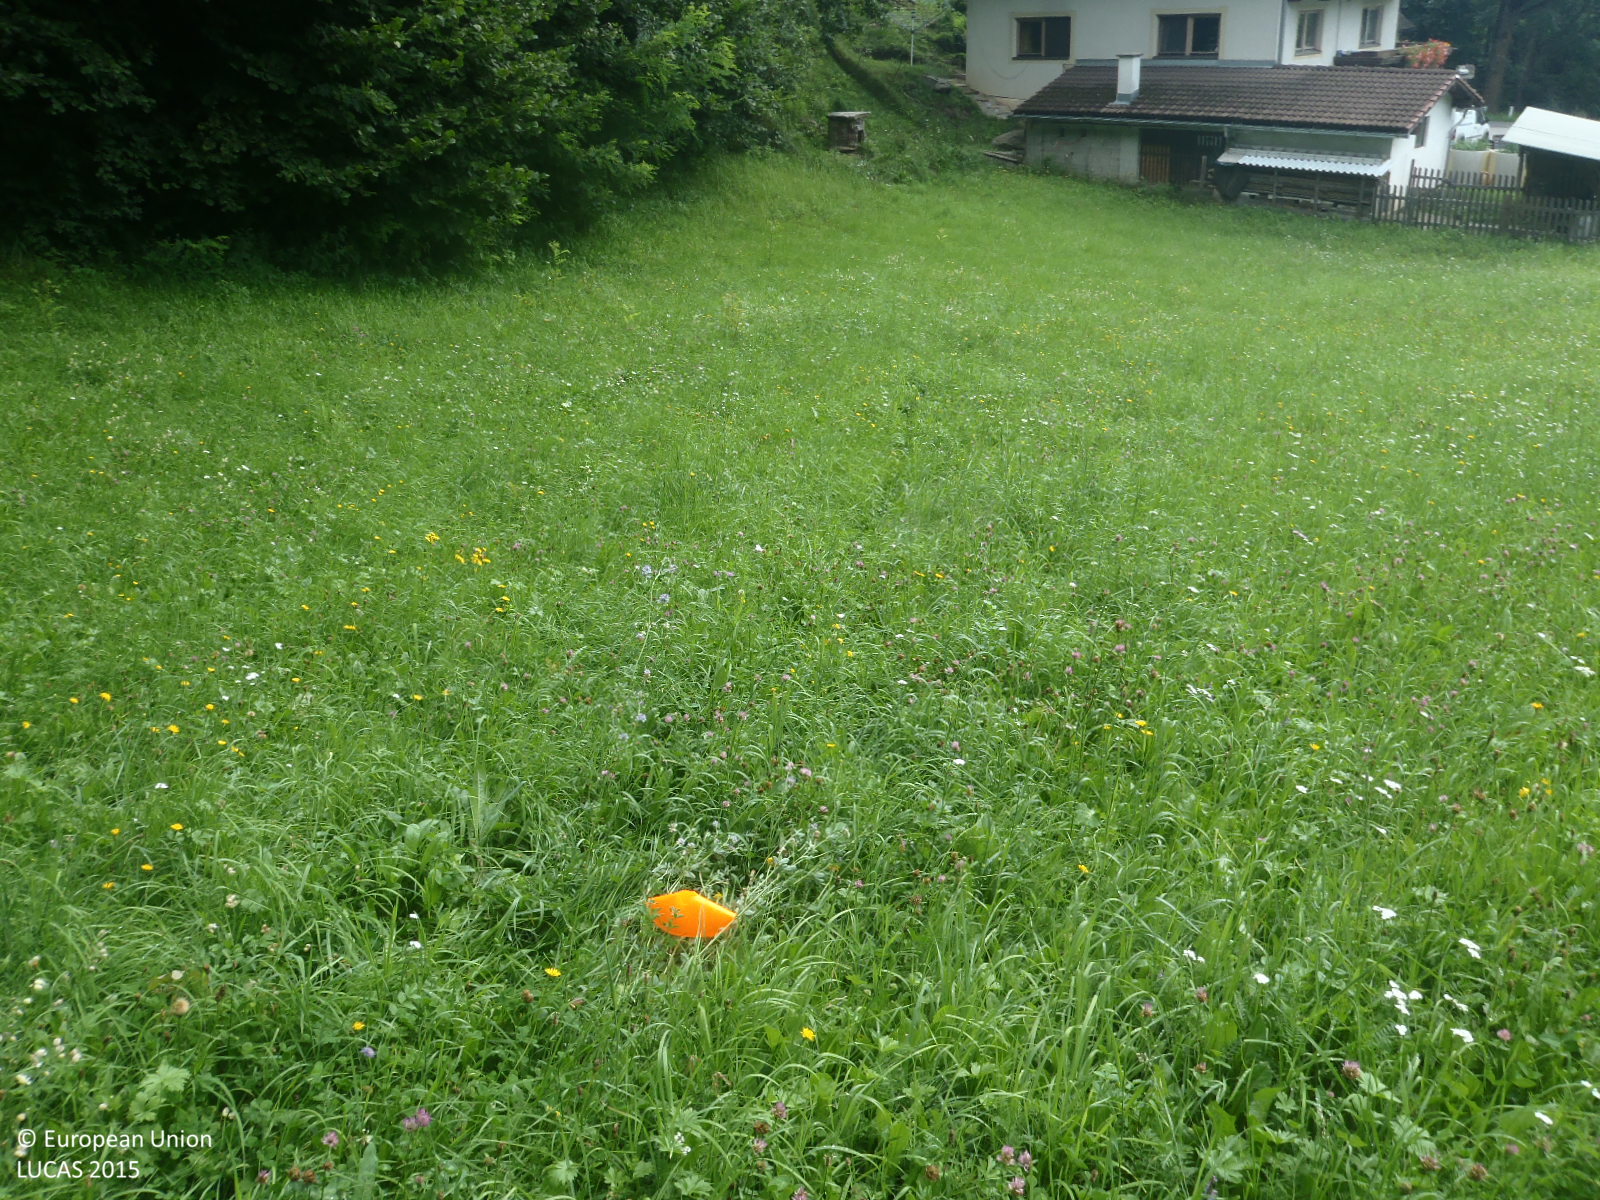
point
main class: Grassland
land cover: Grassland without tree/shrub cover
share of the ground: > 75 %
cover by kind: herbaceous plants 100 %
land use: Agriculture (excluding fallow land and kitchen gardens)
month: August
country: AT
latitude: 46.8767
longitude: 12.6612
